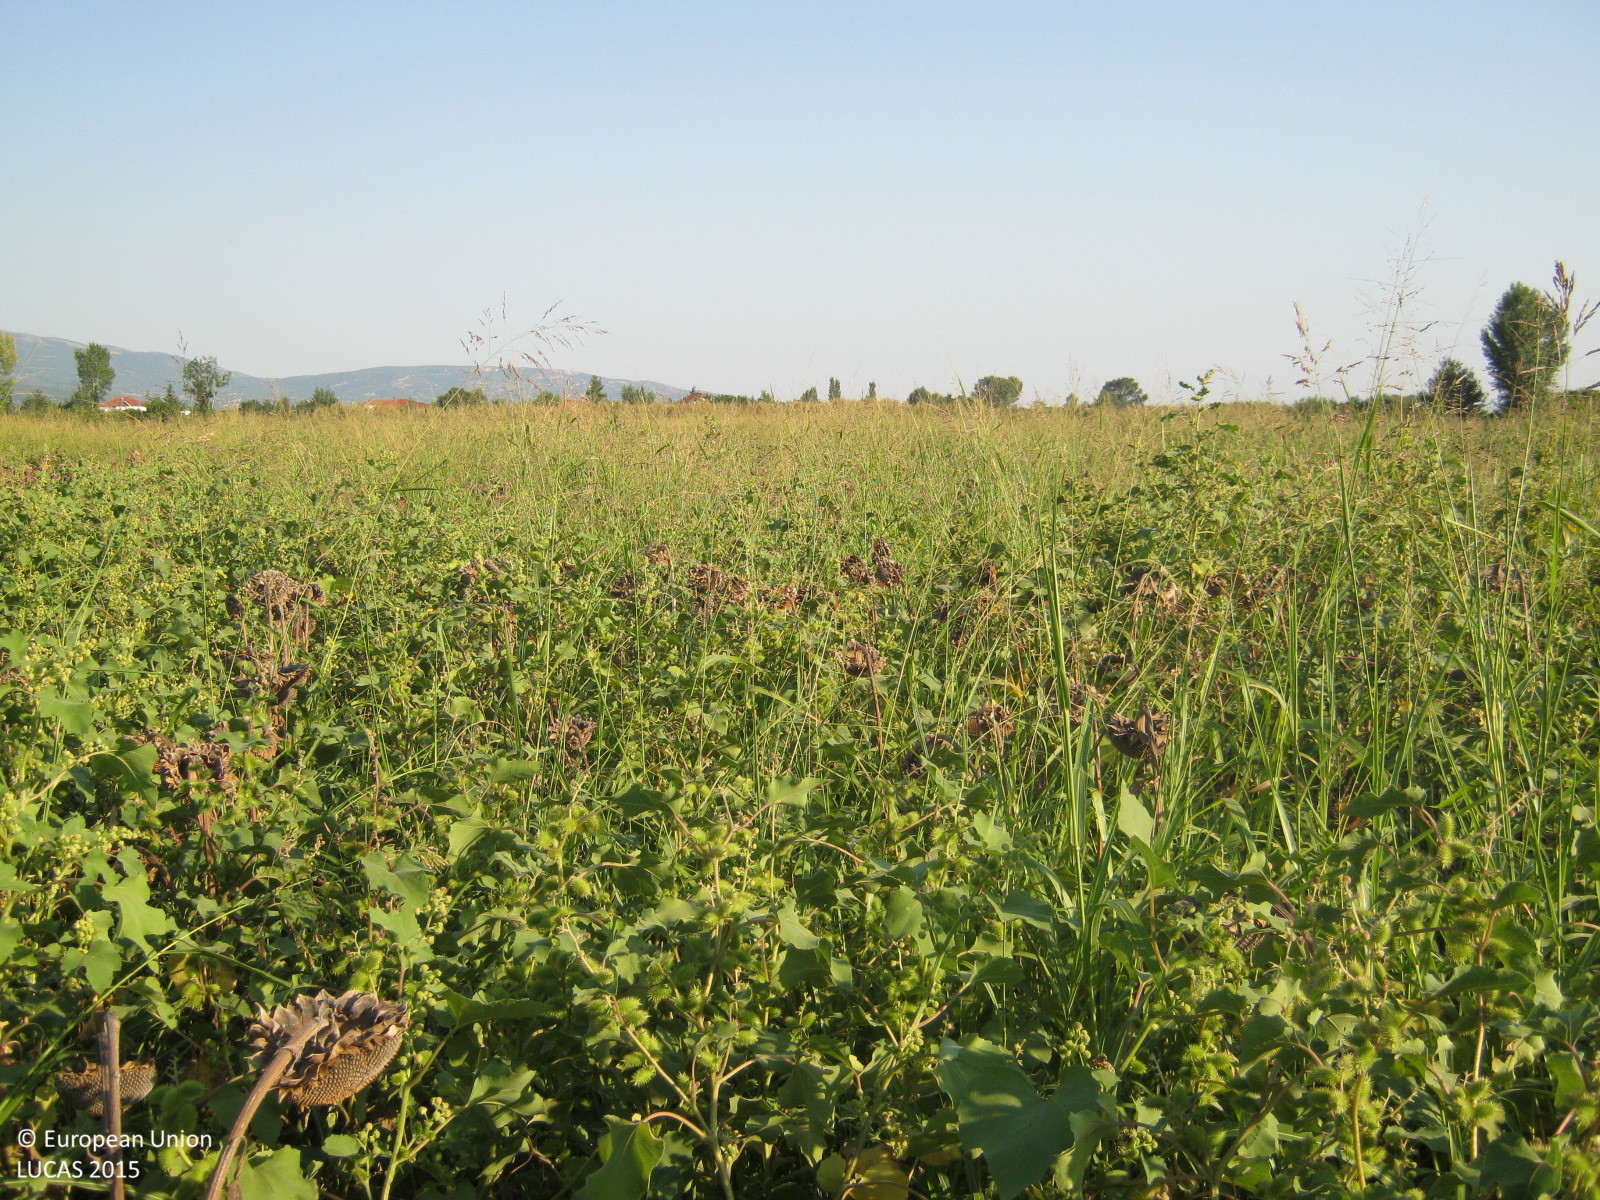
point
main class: Grassland
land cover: Spontaneously vegetated surfaces
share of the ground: > 75 %
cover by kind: herbaceous plants 100 %
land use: Fallow land
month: September
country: GR
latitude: 41.2570
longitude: 23.3265
